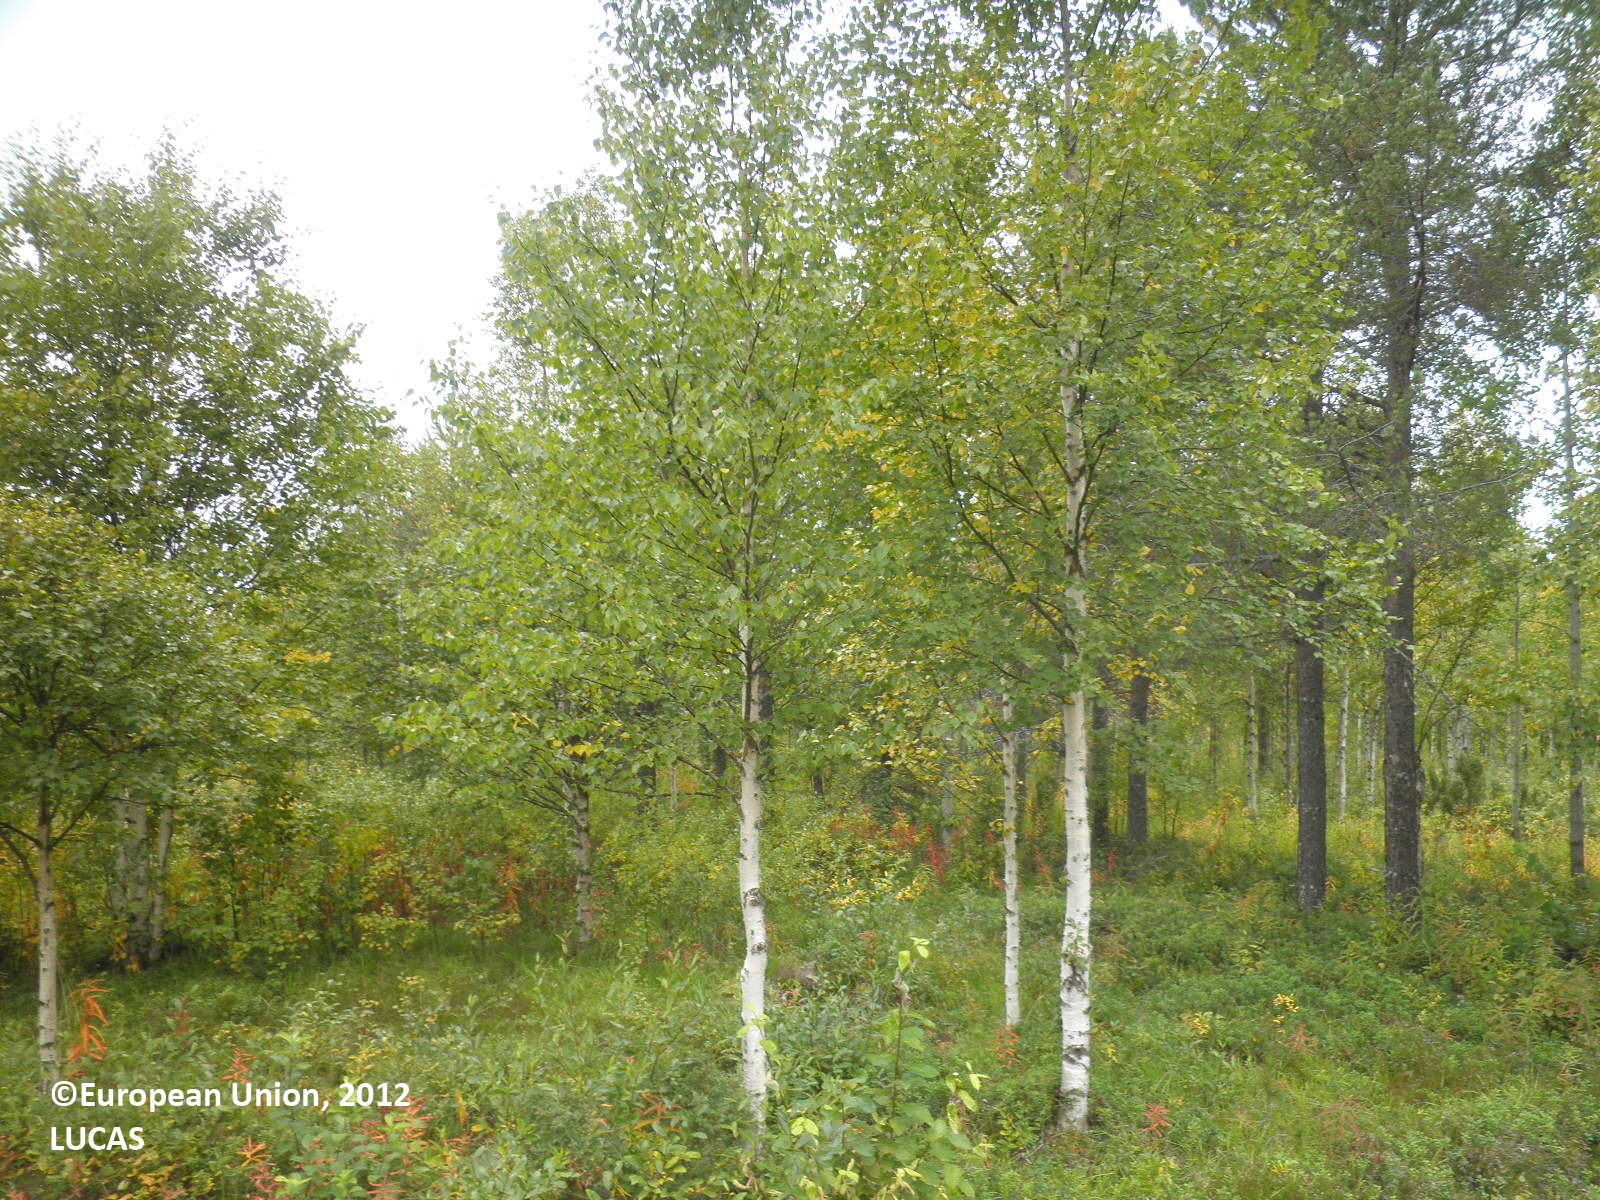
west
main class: Shrubland
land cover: Shrubland with sparse tree cover
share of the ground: > 75 %
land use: Road transport
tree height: < 5 m
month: August
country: FI
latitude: 67.2982
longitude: 28.1626
